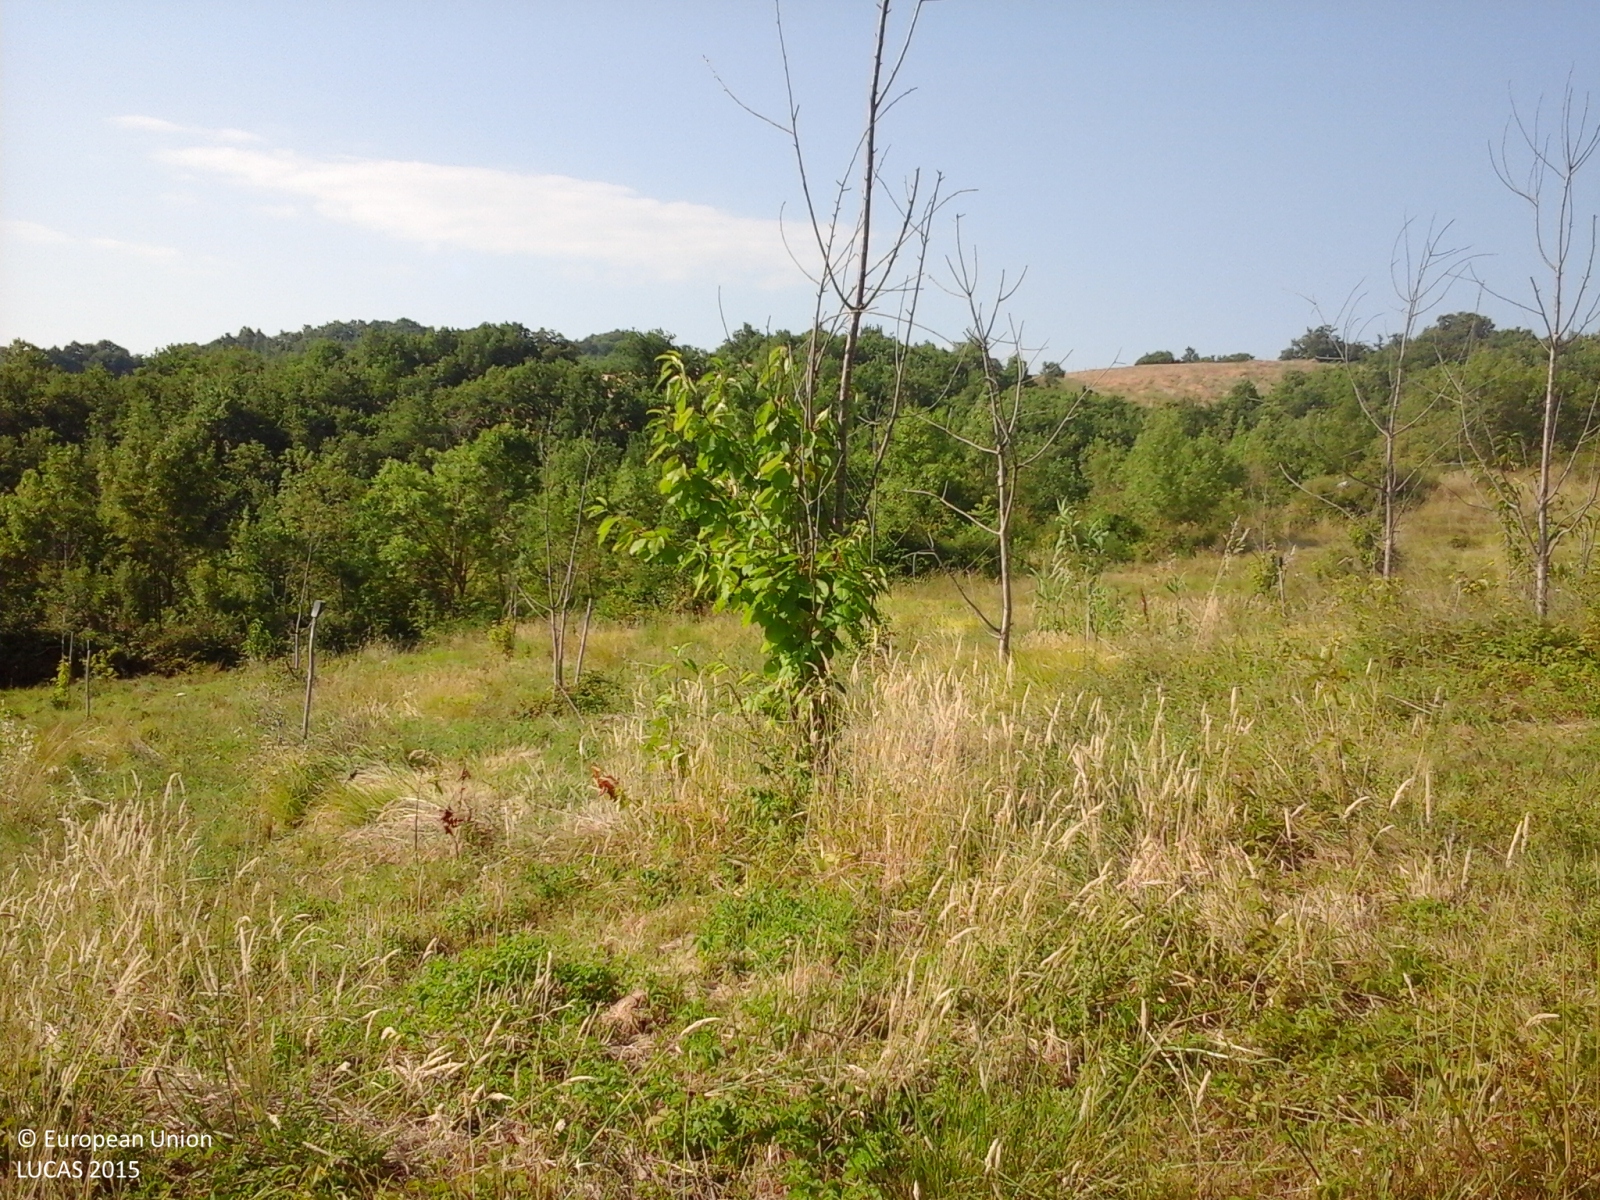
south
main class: Cropland
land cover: Nuts trees
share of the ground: 25 - 50 %
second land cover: Grassland without tree/shrub cover
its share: > 75 %
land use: Agriculture (excluding fallow land and kitchen gardens)
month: July
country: IT
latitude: 41.0977
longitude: 14.6849
